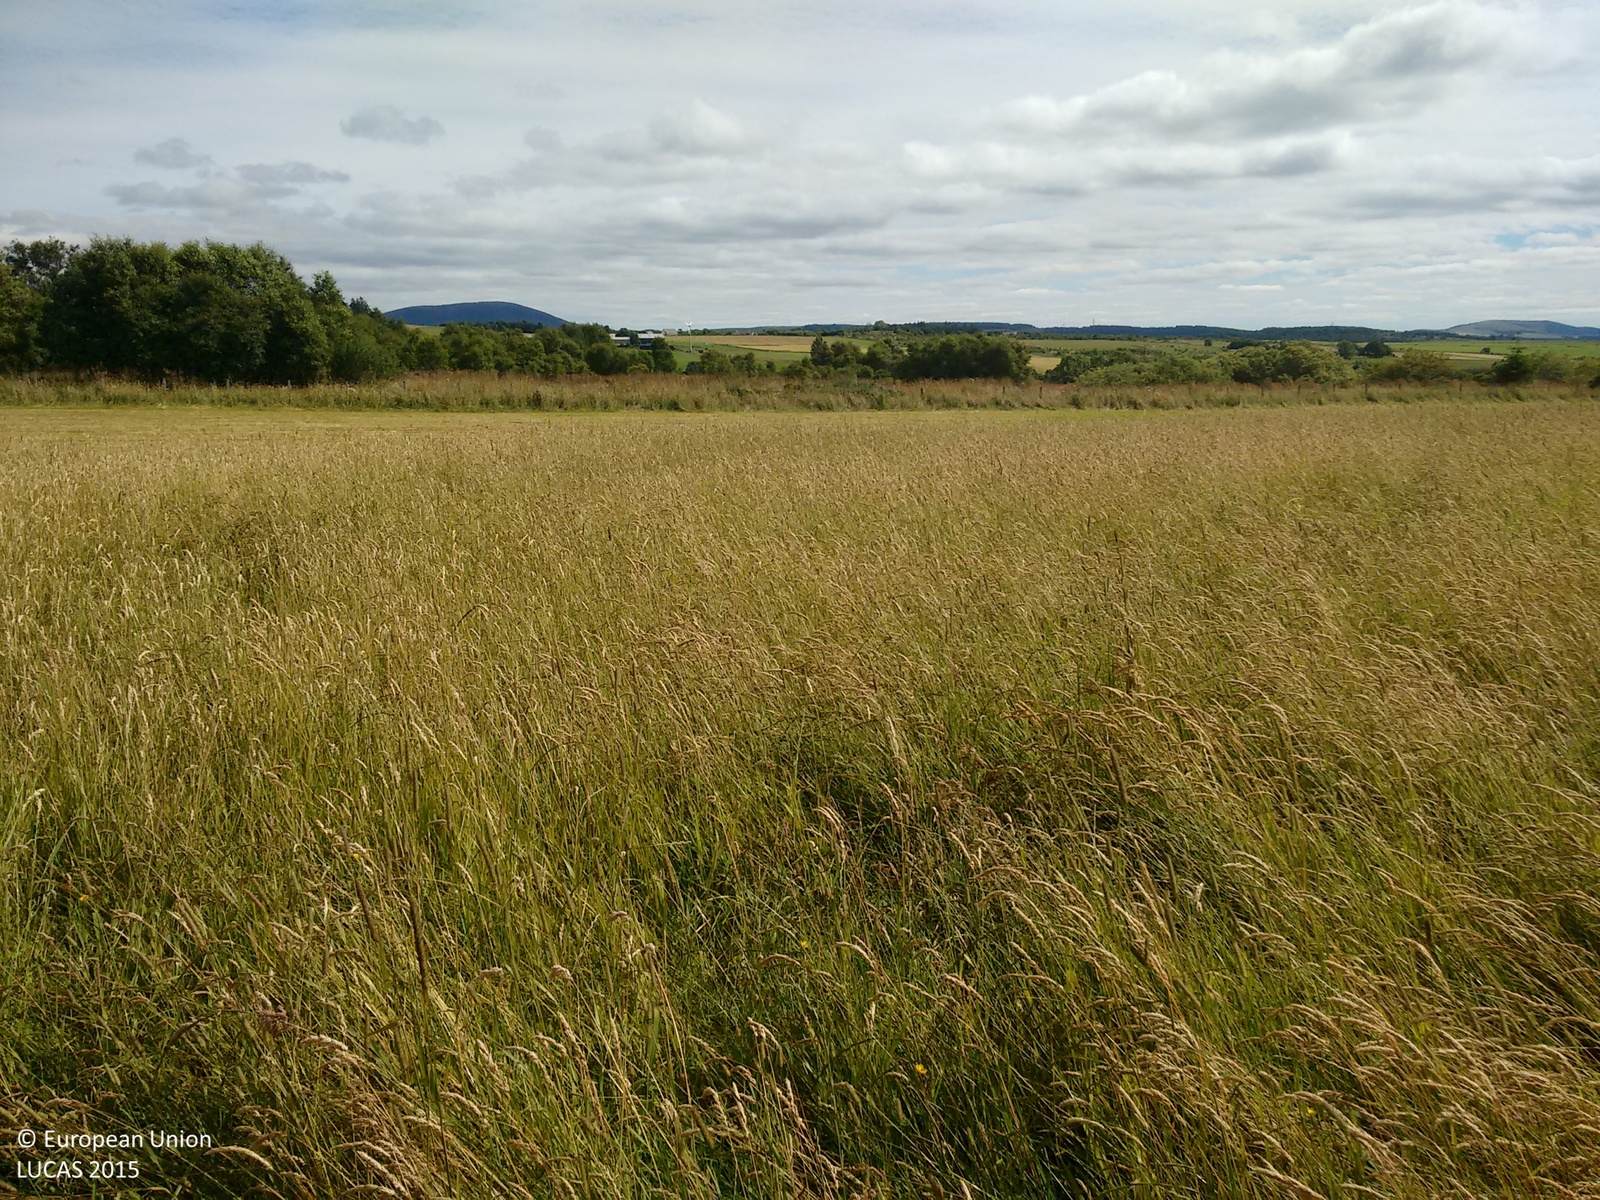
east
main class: Grassland
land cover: Grassland without tree/shrub cover
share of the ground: > 75 %
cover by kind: herbaceous plants 100 %
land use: Agriculture (excluding fallow land and kitchen gardens)
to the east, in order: Grassland without tree/shrub cover; Fences; Ditches and canals; Shrubland with sparse tree cover; Broadleaved woodland; Ditches and canals; Fences; Grassland without tree/shrub cover
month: August
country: GB
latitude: 57.5744
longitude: -2.9180
